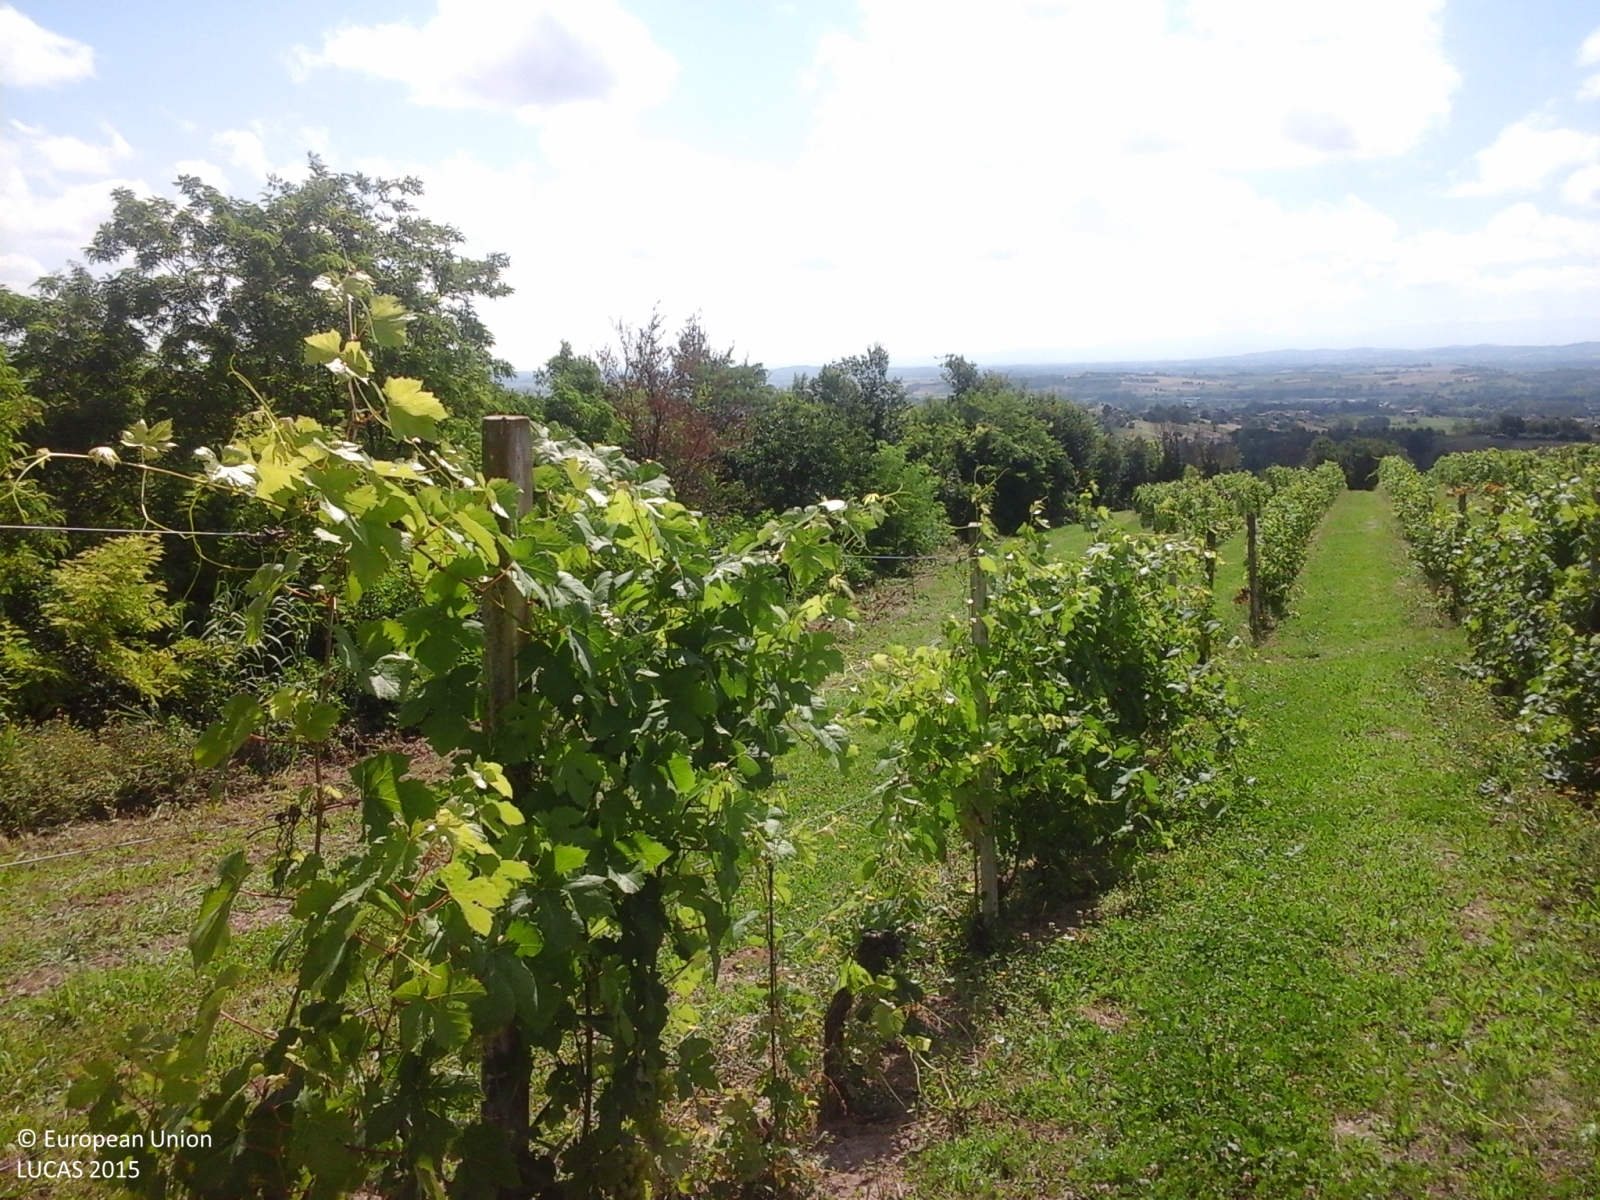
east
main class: Cropland
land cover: Vineyards
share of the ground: > 75 %
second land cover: Grassland without tree/shrub cover
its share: > 75 %
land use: Agriculture (excluding fallow land and kitchen gardens)
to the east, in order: Vineyards; Grassland without tree/shrub cover; Grass margins; Broadleaved woodland; Tracks; Broadleaved woodland
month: June
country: IT
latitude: 45.0779
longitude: 8.4150
